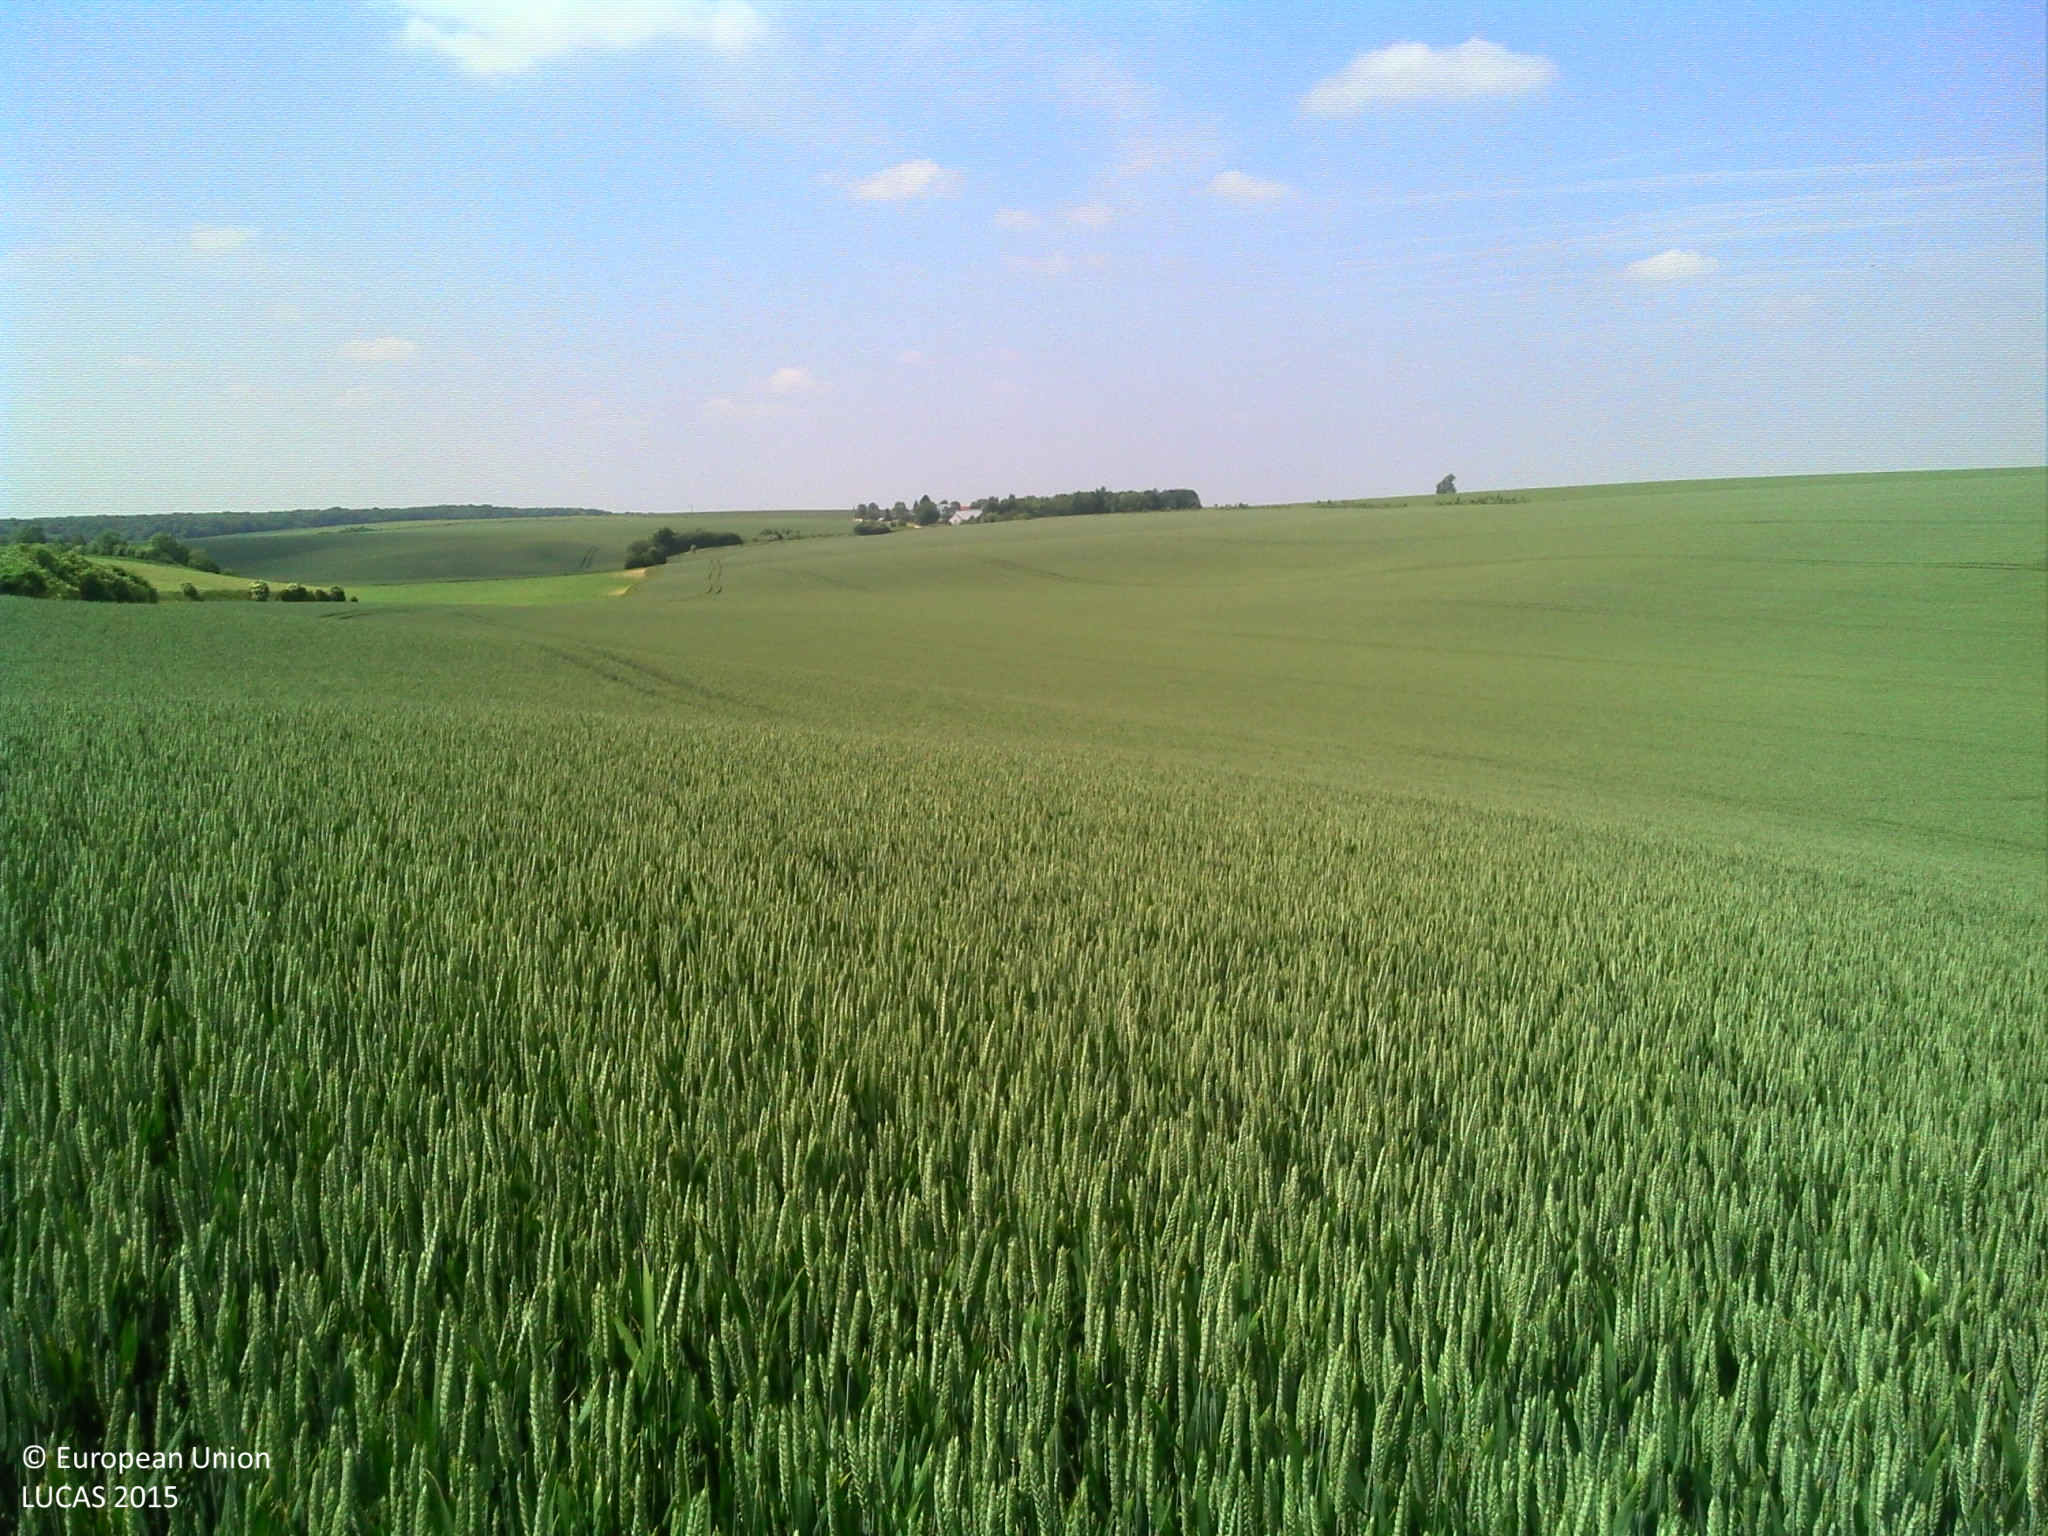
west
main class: Cropland
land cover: Common wheat
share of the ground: > 75 %
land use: Agriculture (excluding fallow land and kitchen gardens)
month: June
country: FR
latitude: 49.5951
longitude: 4.0319
